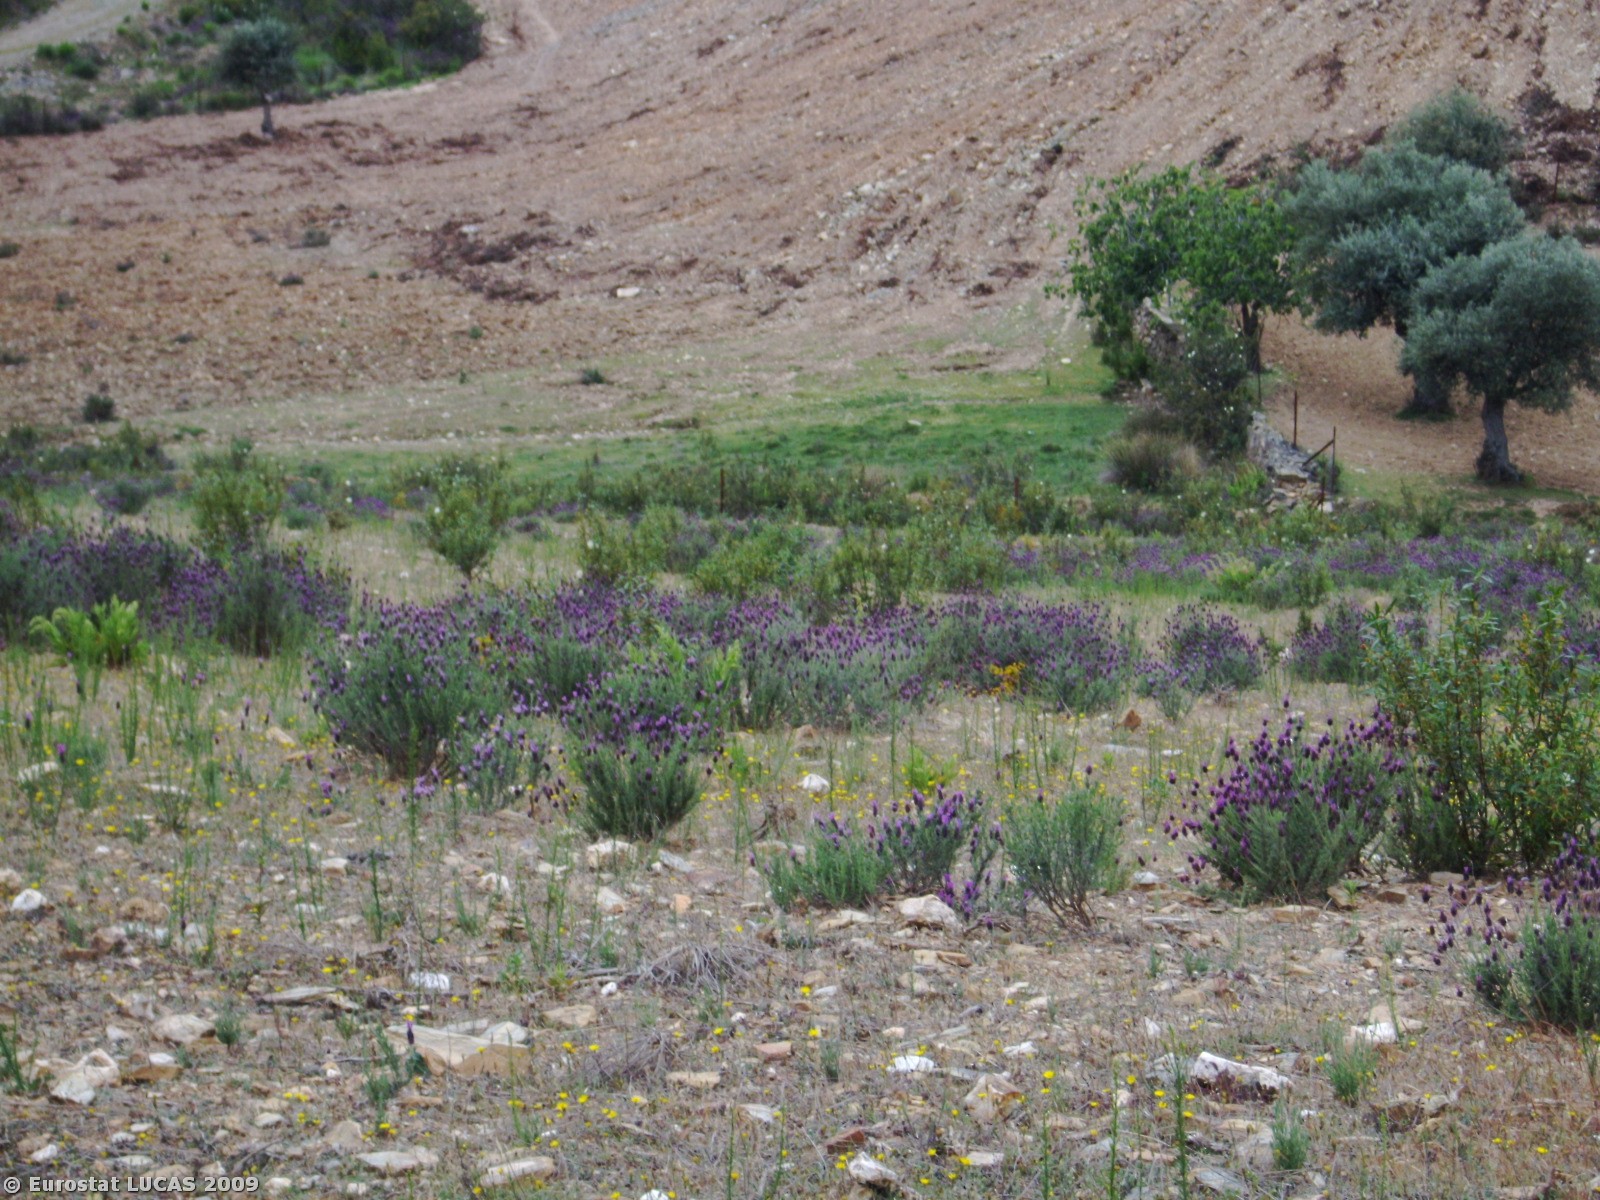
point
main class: Grassland
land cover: Spontaneously vegetated surfaces
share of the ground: > 75 %
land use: Fallow land
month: April
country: PT
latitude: 39.7865
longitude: -7.5092
